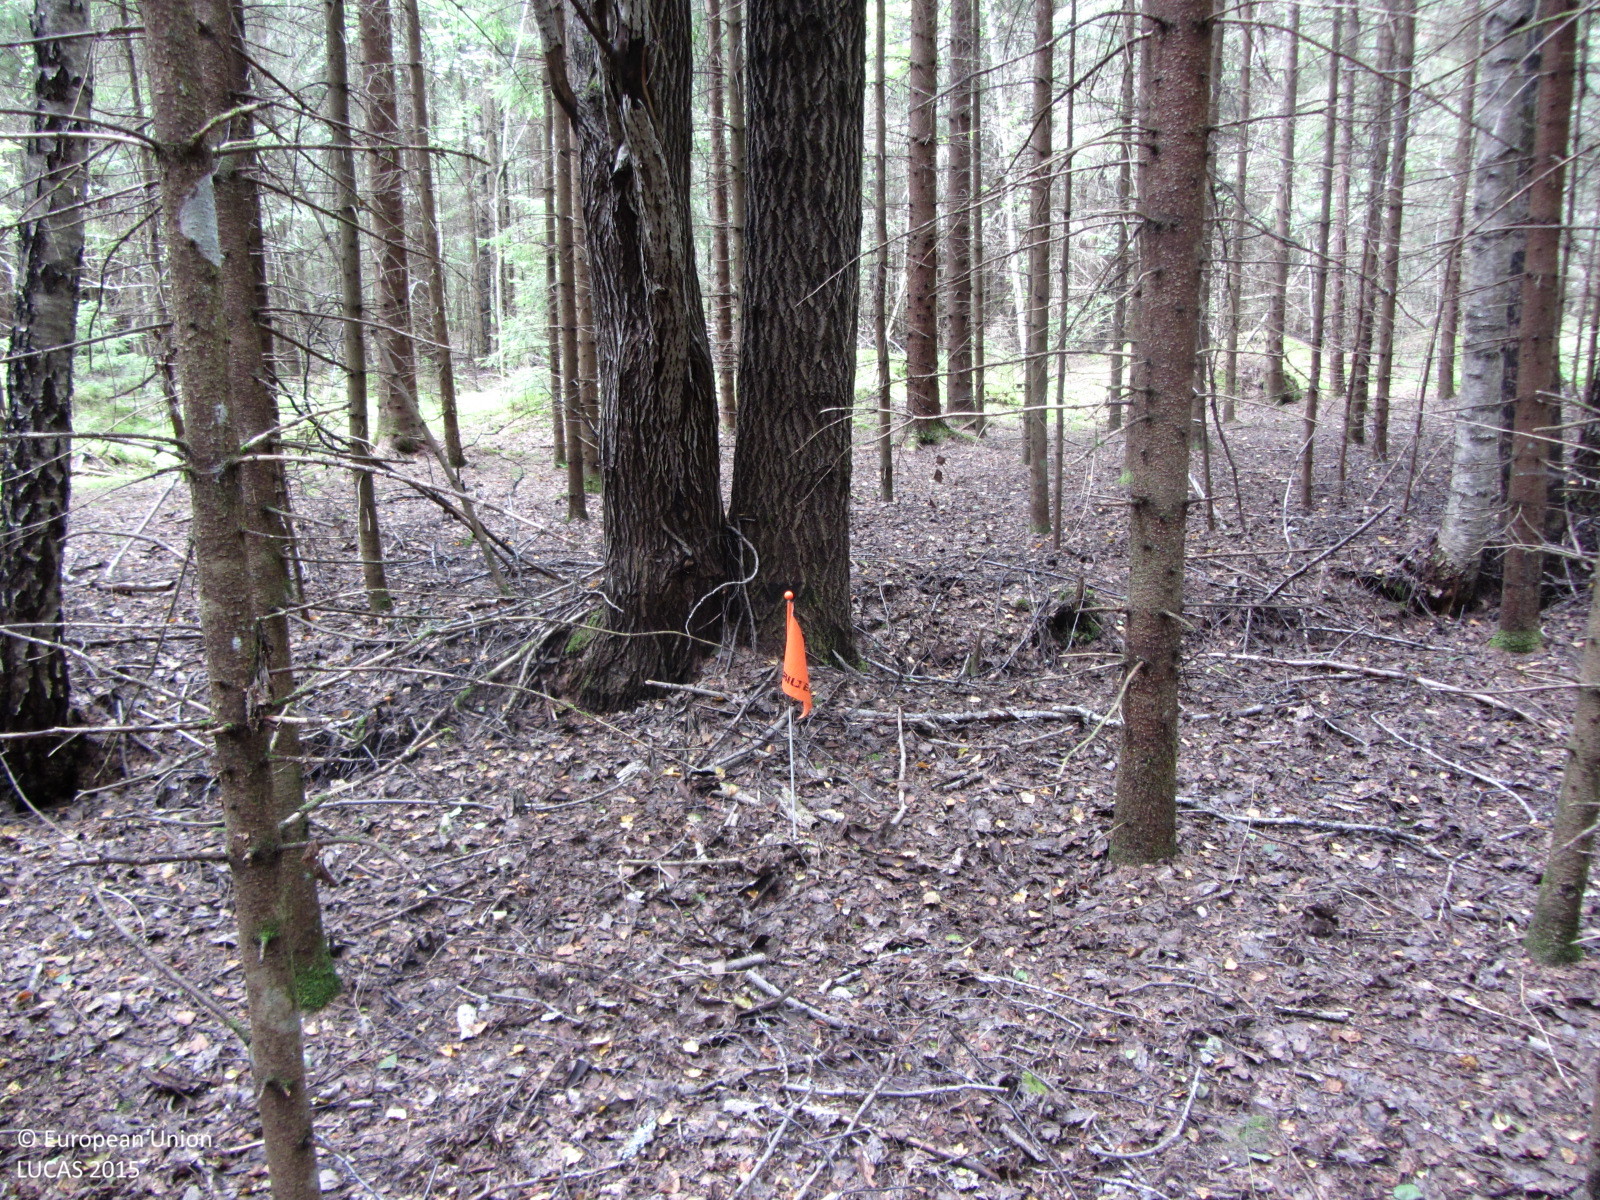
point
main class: Woodland
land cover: Spruce dominated mixed woodland
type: boreal forest
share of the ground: > 75 %
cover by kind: coniferous forest trees 70 %, broadleaved forest trees 30 %
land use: Forestry
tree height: > 5 m
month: August
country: FI
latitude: 60.2835
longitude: 23.8207
